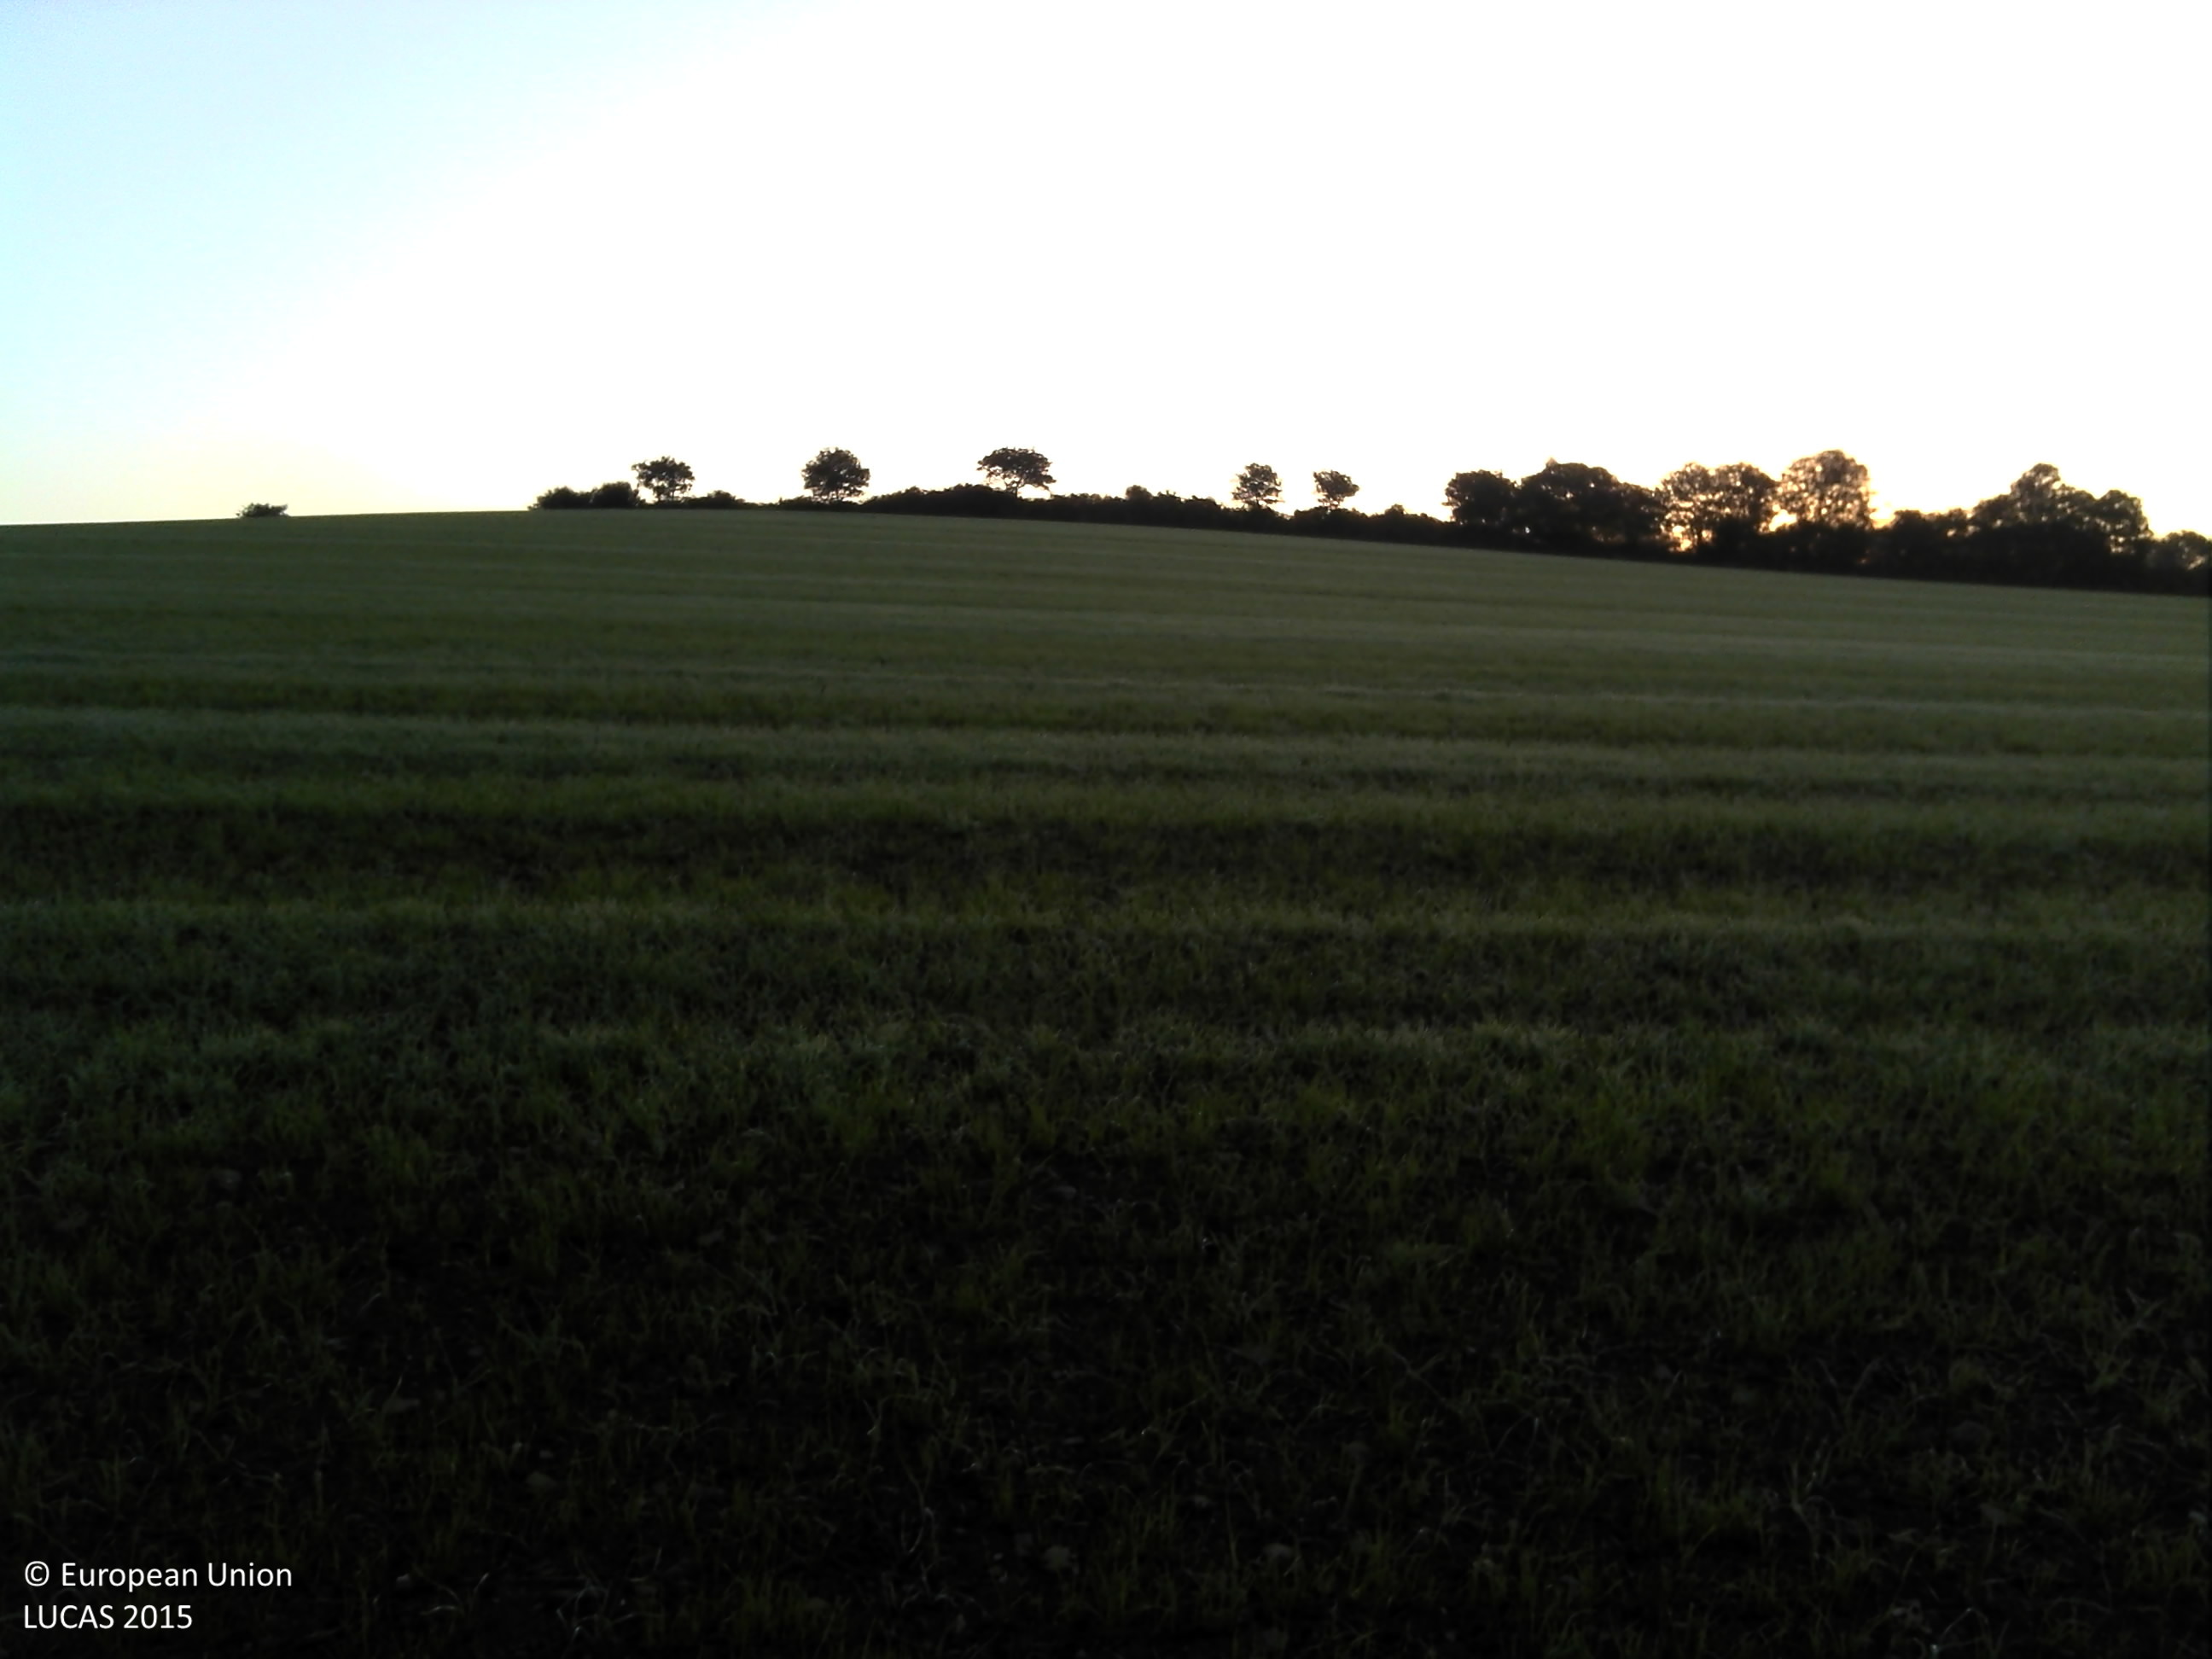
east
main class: Cropland
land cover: Temporary grasslands
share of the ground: 50 - 75 %
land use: Agriculture (excluding fallow land and kitchen gardens)
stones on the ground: 10 - 25 %
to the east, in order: Temporary grasslands; Abandoned hedges; Fences; Grassland without tree/shrub cover
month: September
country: FR
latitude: 48.2575
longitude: -3.6994
